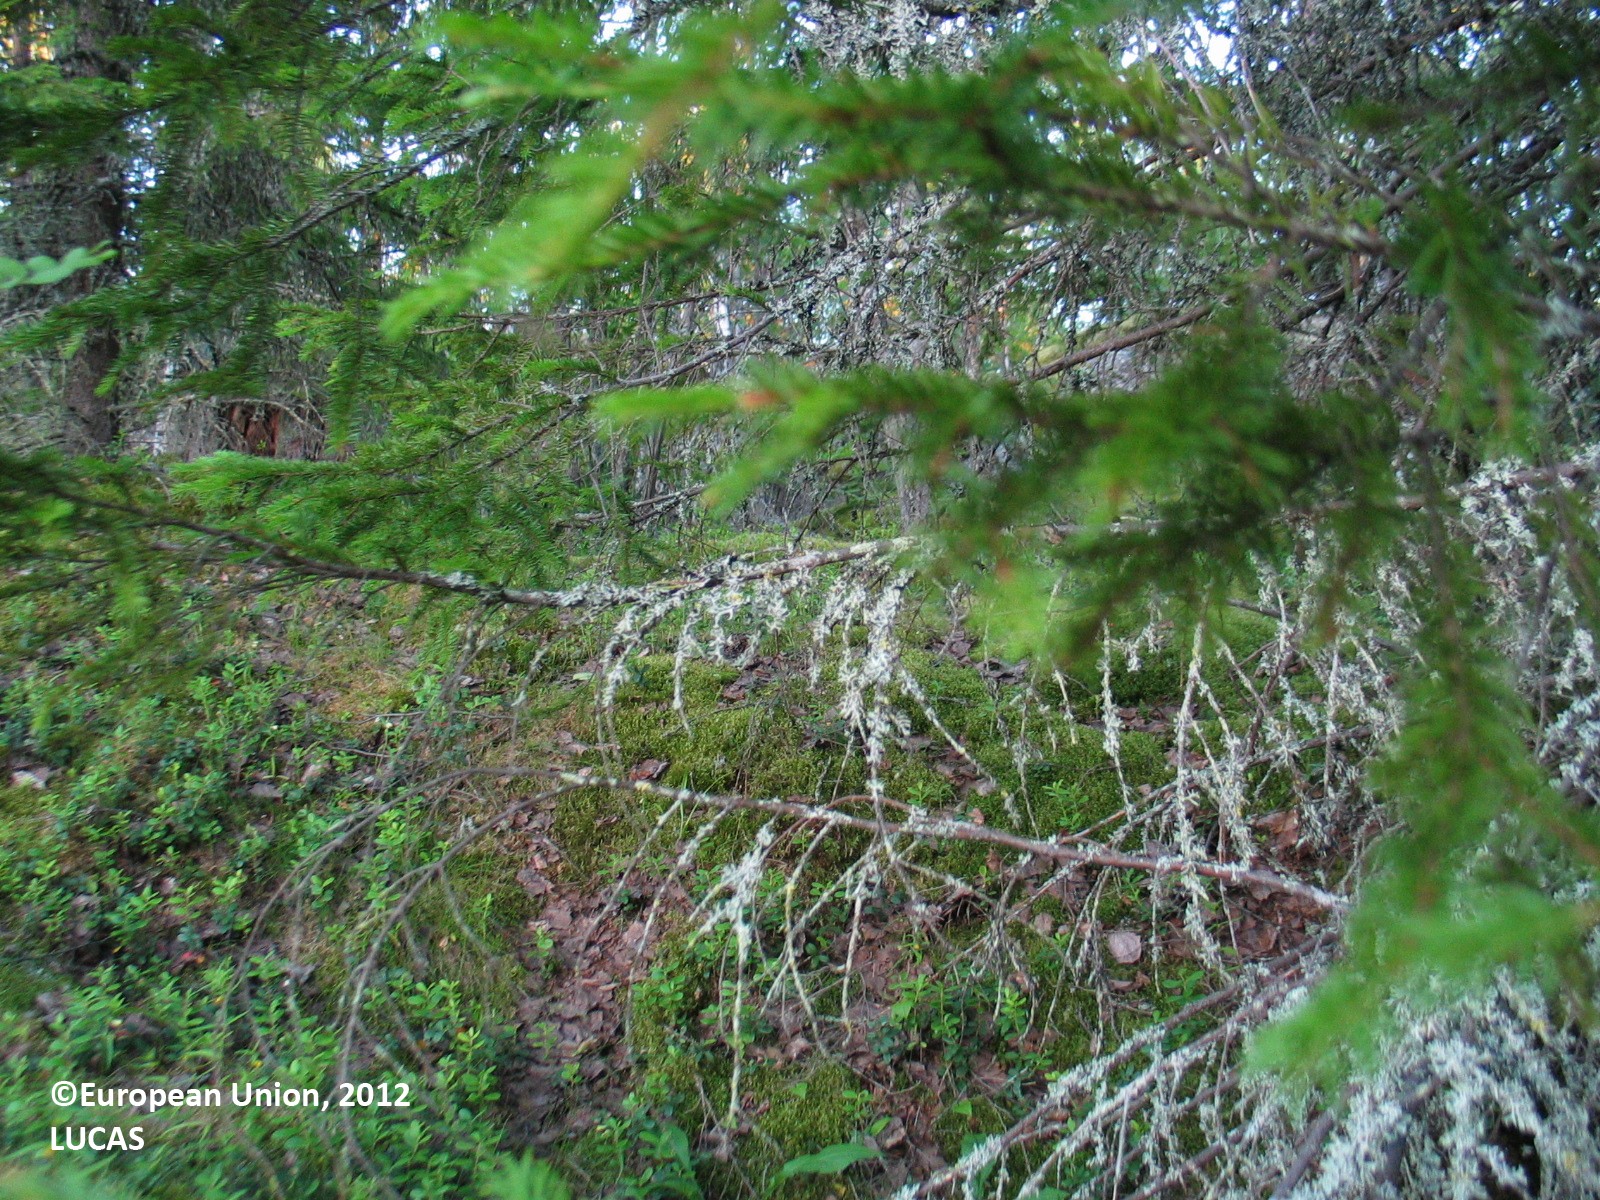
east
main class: Woodland
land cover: Other mixed woodland
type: boreal forest
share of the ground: 25 - 50 %
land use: Forestry
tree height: > 5 m
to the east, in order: Other mixed woodland
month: July
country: FI
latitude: 65.8960
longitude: 25.0059
